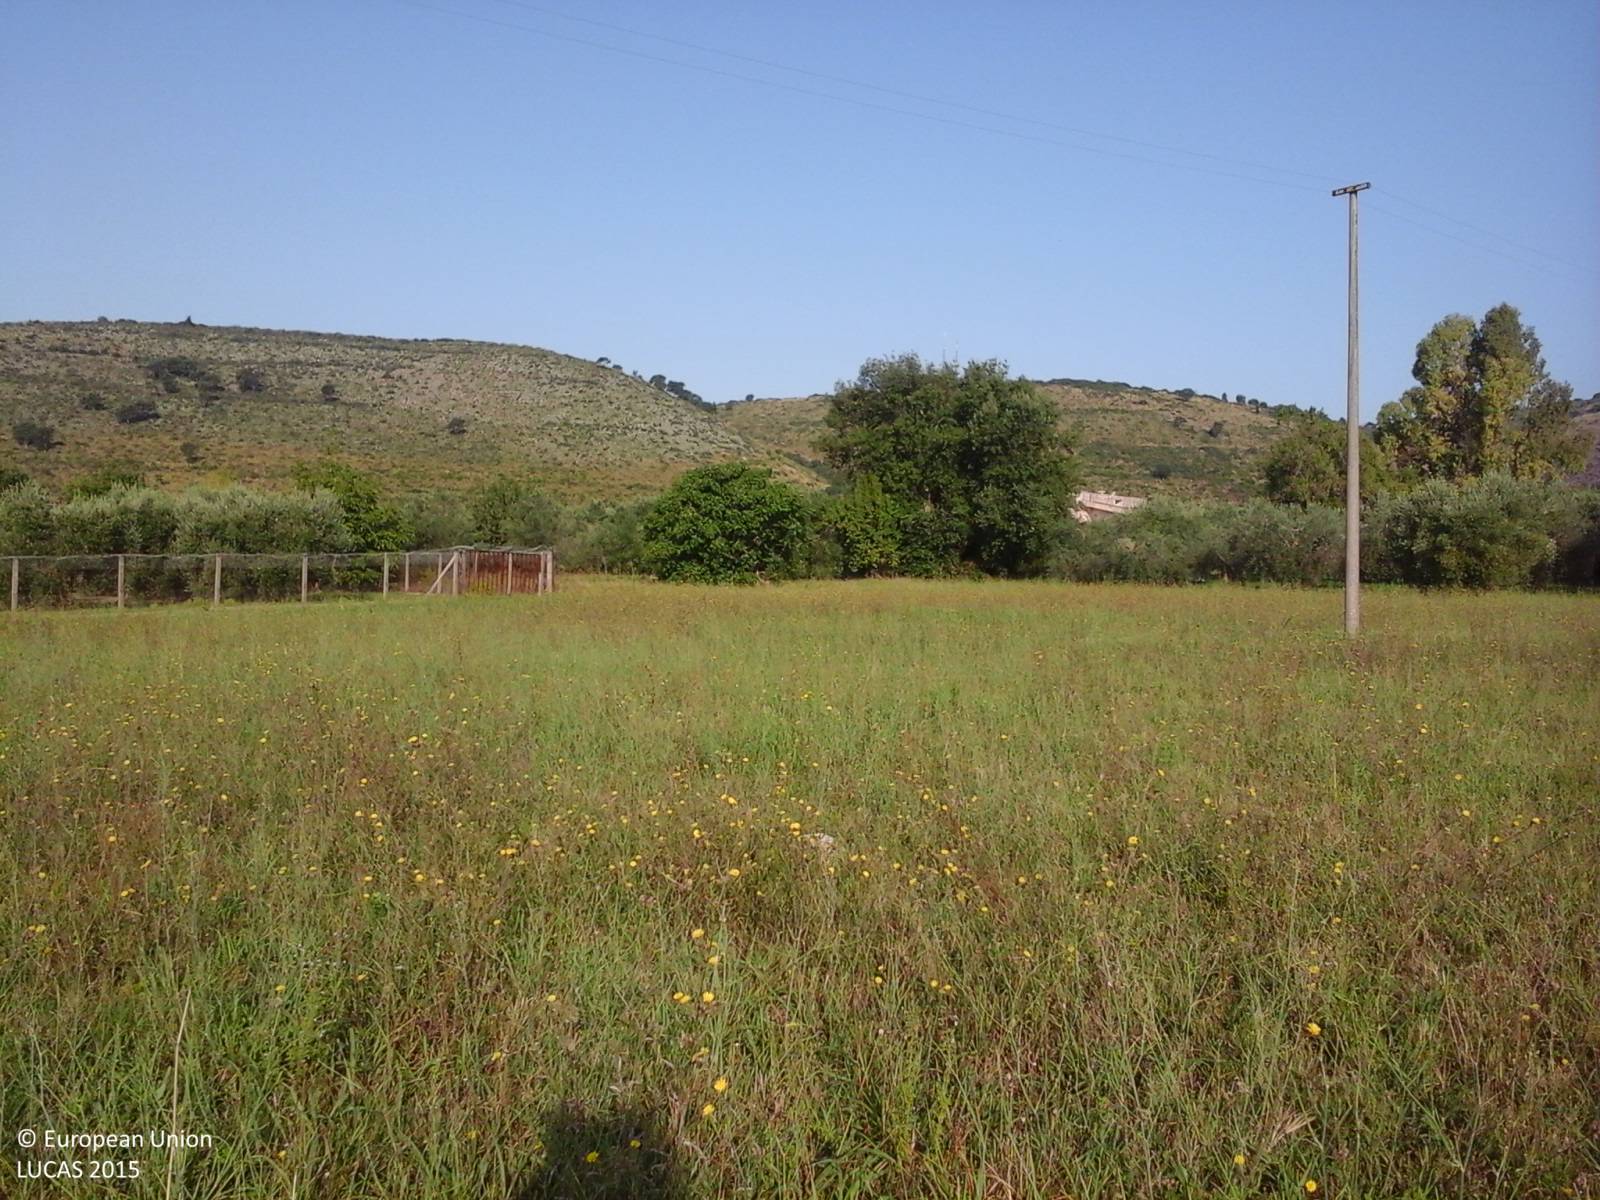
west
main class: Grassland
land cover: Spontaneously vegetated surfaces
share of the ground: > 75 %
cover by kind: herbaceous plants 100 %
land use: Agriculture (excluding fallow land and kitchen gardens)
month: August
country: IT
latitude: 41.4851
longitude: 13.1136
